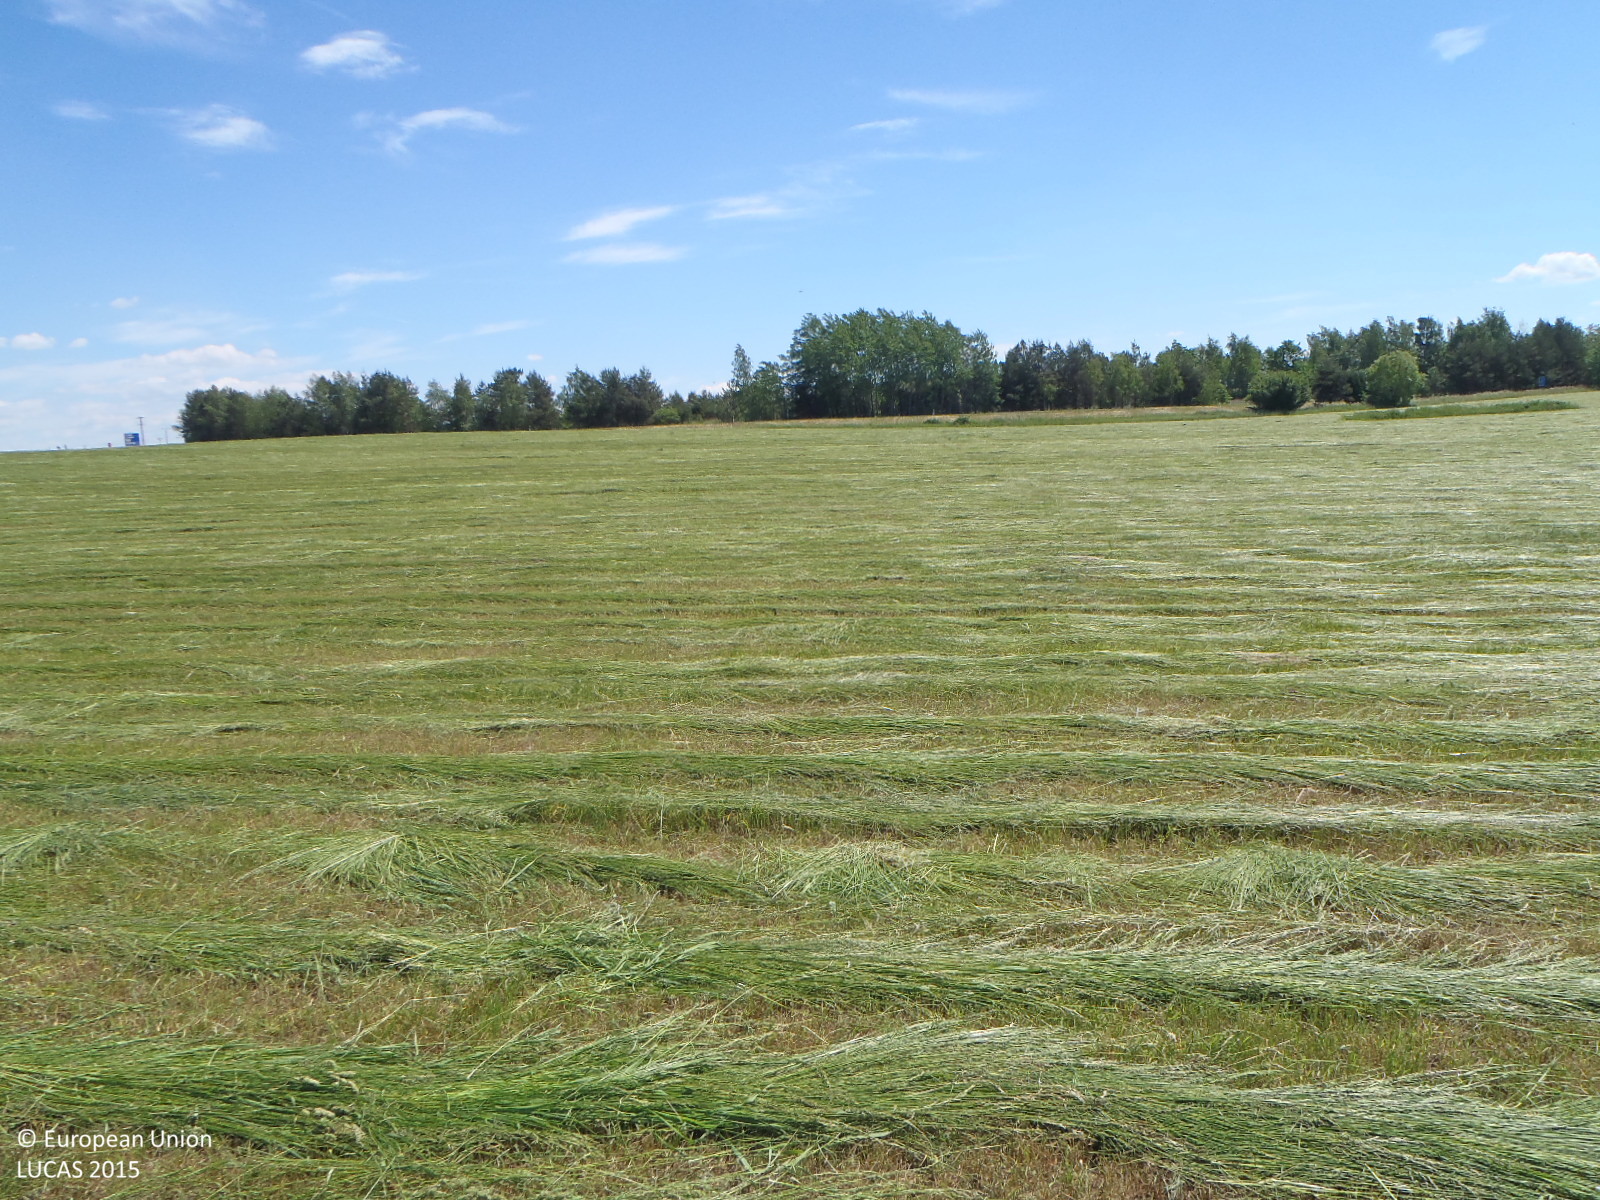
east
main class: Grassland
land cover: Grassland without tree/shrub cover
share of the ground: > 75 %
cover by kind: herbaceous plants 100 %
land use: Agriculture (excluding fallow land and kitchen gardens)
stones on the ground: < 10 %
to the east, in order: Grassland without tree/shrub cover; Paved roads, cycling and walking lanes; Grass margins; Ditches and canals; Pine dominated coniferous woodland
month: June
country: CZ
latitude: 48.8912
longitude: 14.4337
